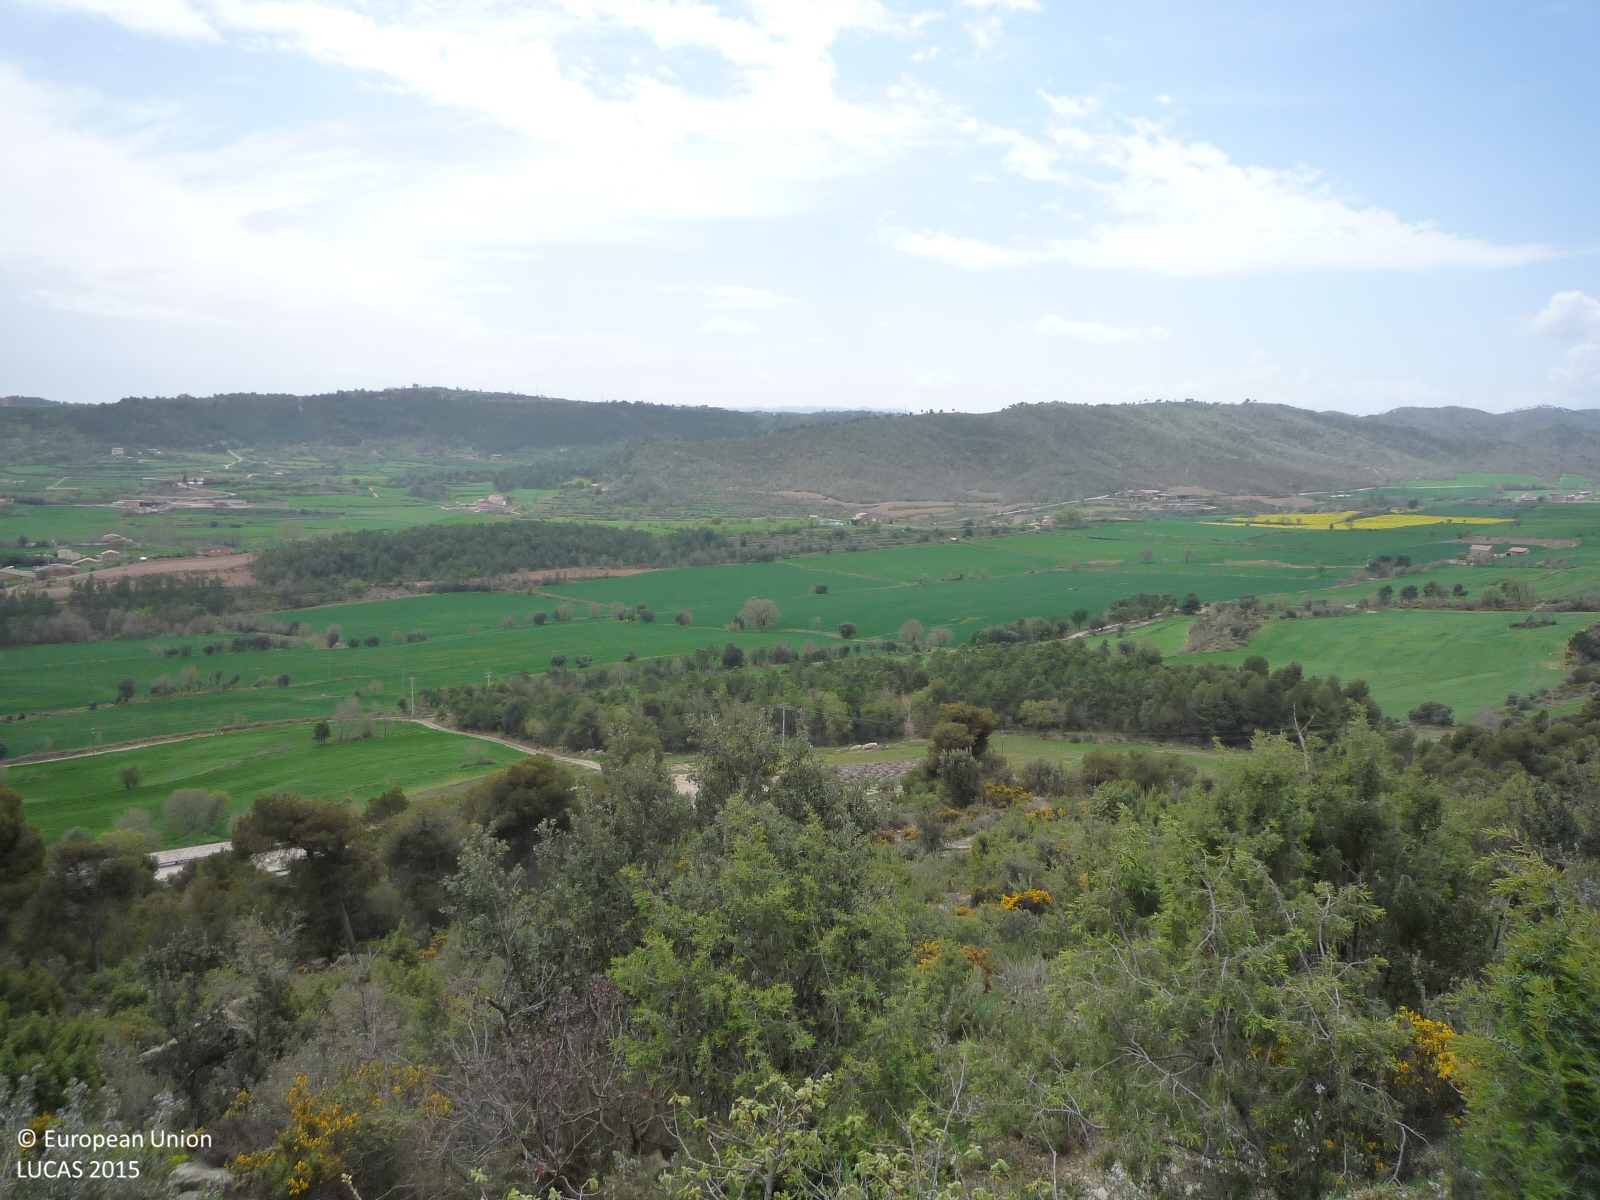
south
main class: Shrubland
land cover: Shrubland without tree cover
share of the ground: > 75 %
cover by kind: shrubs 75 %, lichens and mosses 15 %, herbaceous plants 10 %
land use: Semi-natural and natural areas not in use
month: April
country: ES
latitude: 41.9281
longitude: 1.6564
